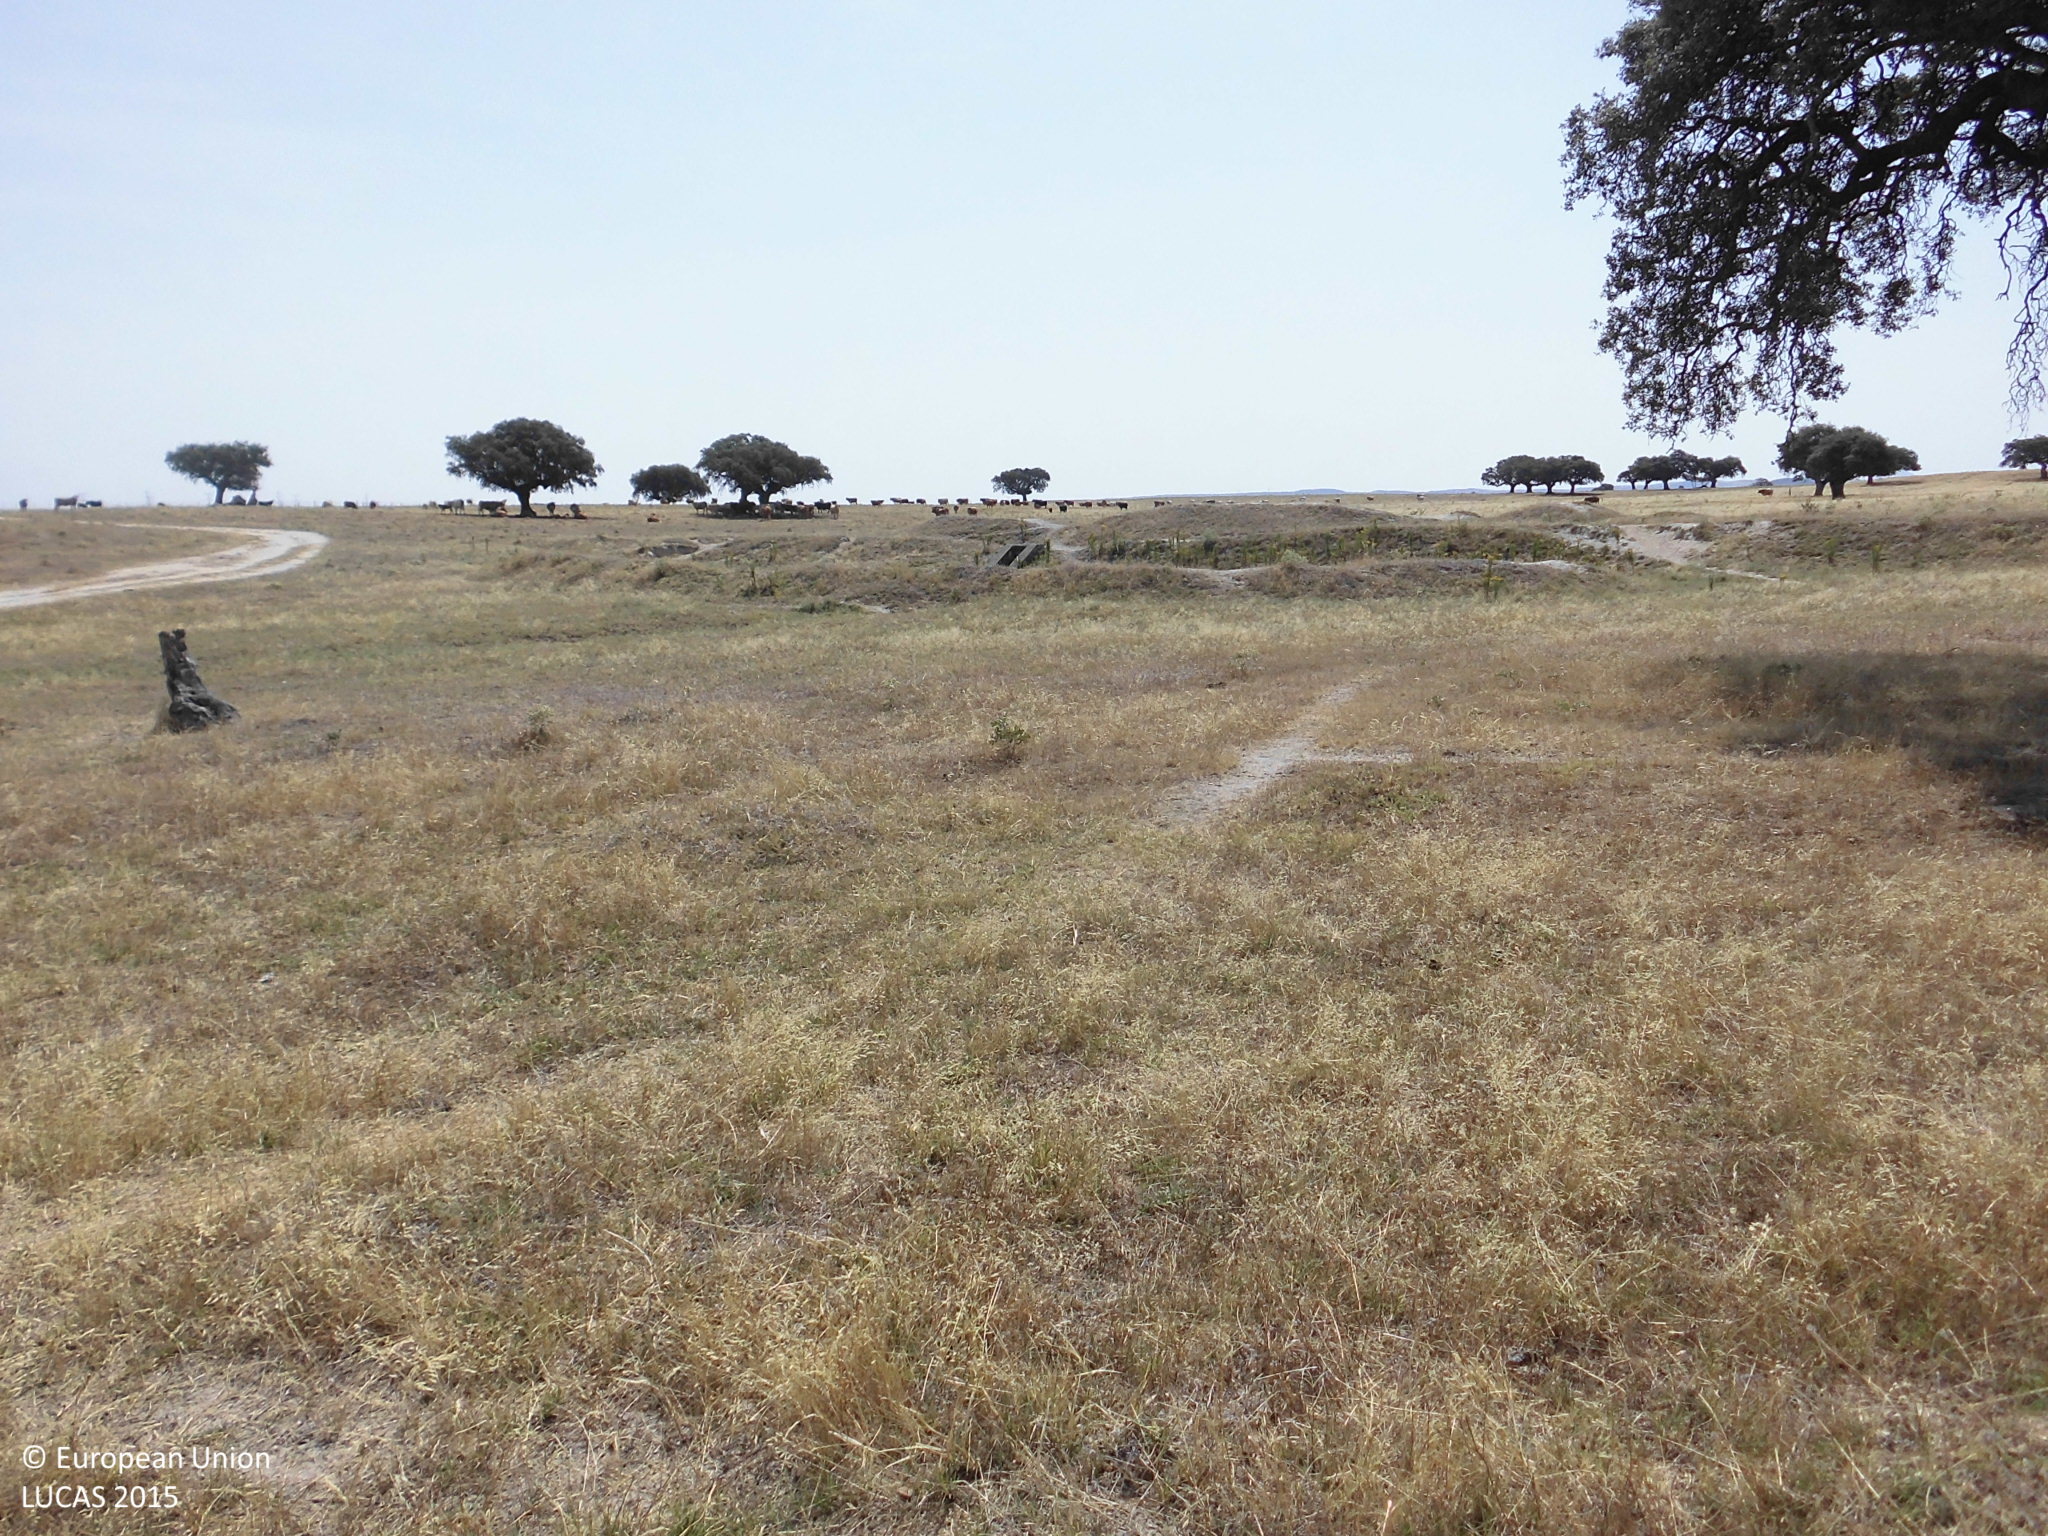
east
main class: Woodland
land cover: Broadleaved woodland
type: broadleaved evergreen forest
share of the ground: 10 - 25 %
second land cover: Grassland without tree/shrub cover
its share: > 75 %
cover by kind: herbaceous plants 85 %, broadleaved forest trees 10 %, unconsolidated bare surface 5 %
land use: Forestry
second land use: Agriculture (excluding fallow land and kitchen gardens)
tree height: > 5 m
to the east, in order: Broadleaved woodland; Grassland without tree/shrub cover; Broadleaved woodland; Grassland without tree/shrub cover
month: July
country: ES
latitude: 39.9047
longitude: -5.4150
